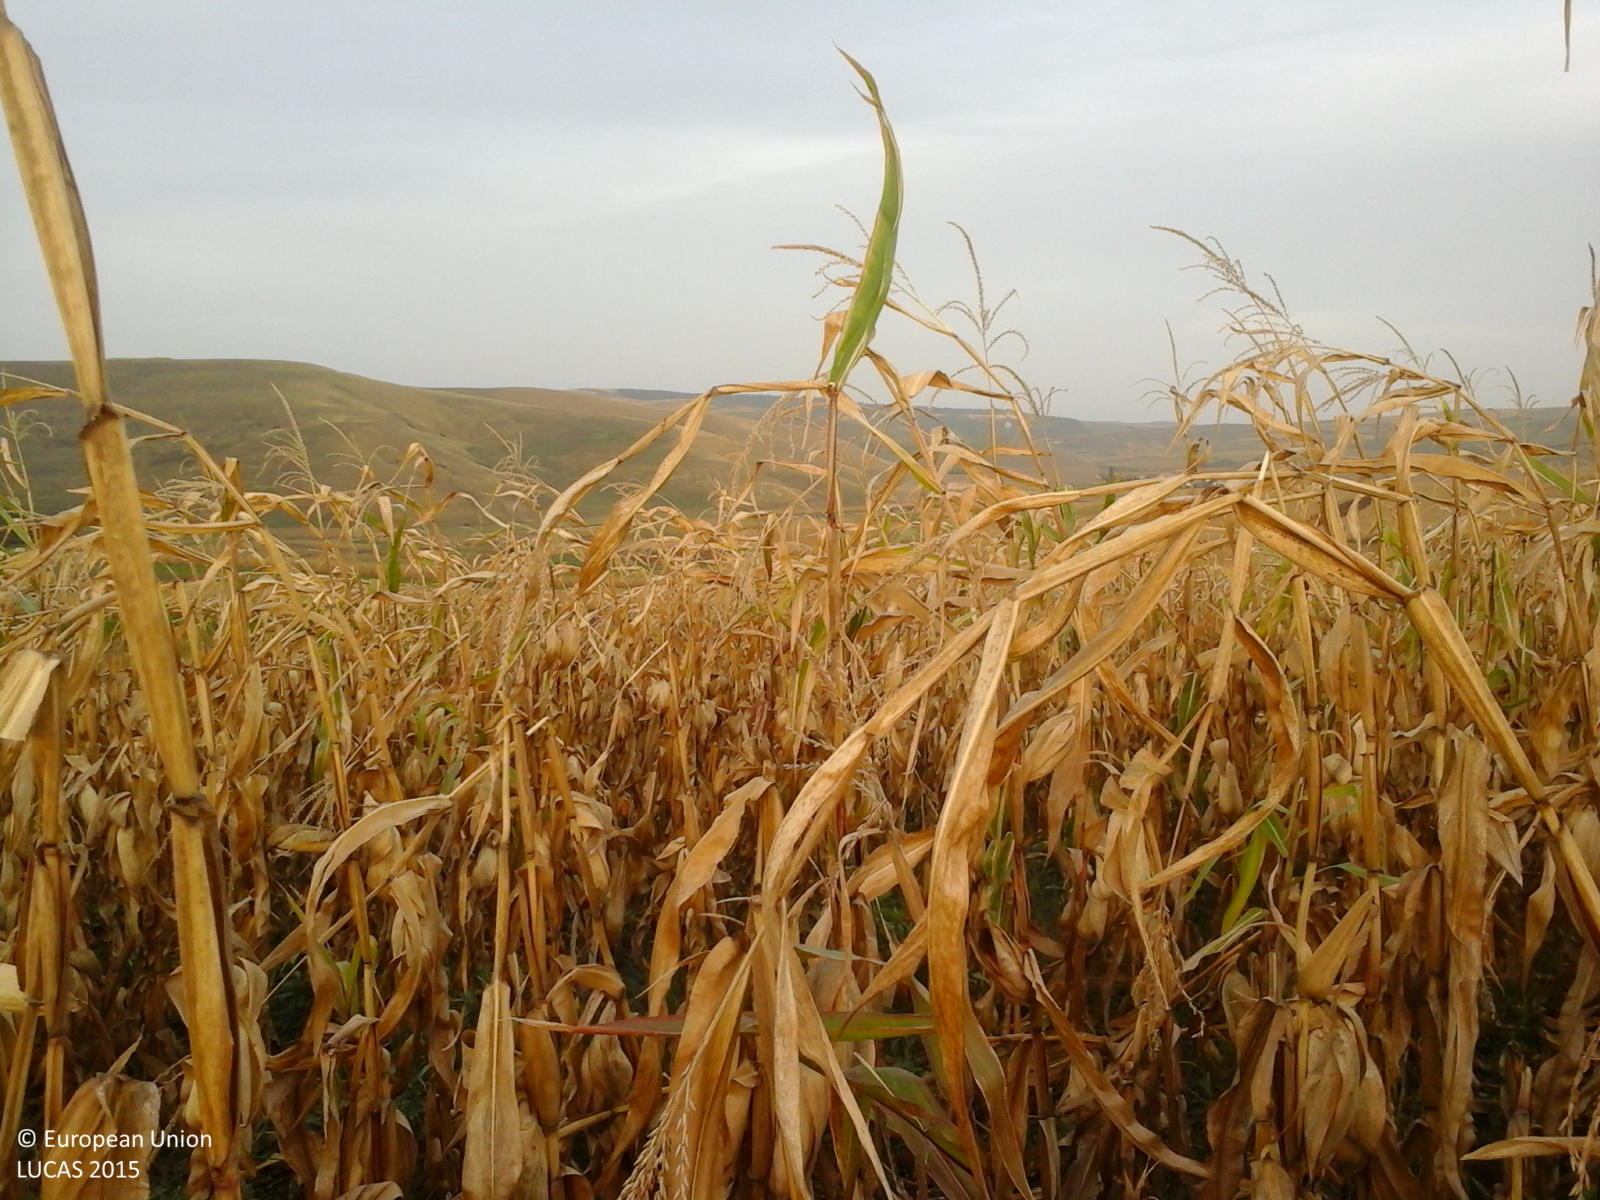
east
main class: Cropland
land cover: Maize
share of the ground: > 75 %
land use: Agriculture (excluding fallow land and kitchen gardens)
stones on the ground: < 10 %
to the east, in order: Maize; Other bare soil; Spontaneously vegetated surfaces; Tracks; Durum wheat; Tracks; Grassland without tree/shrub cover; Maize; Durum wheat
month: September
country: RO
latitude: 46.5439
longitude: 23.9649
